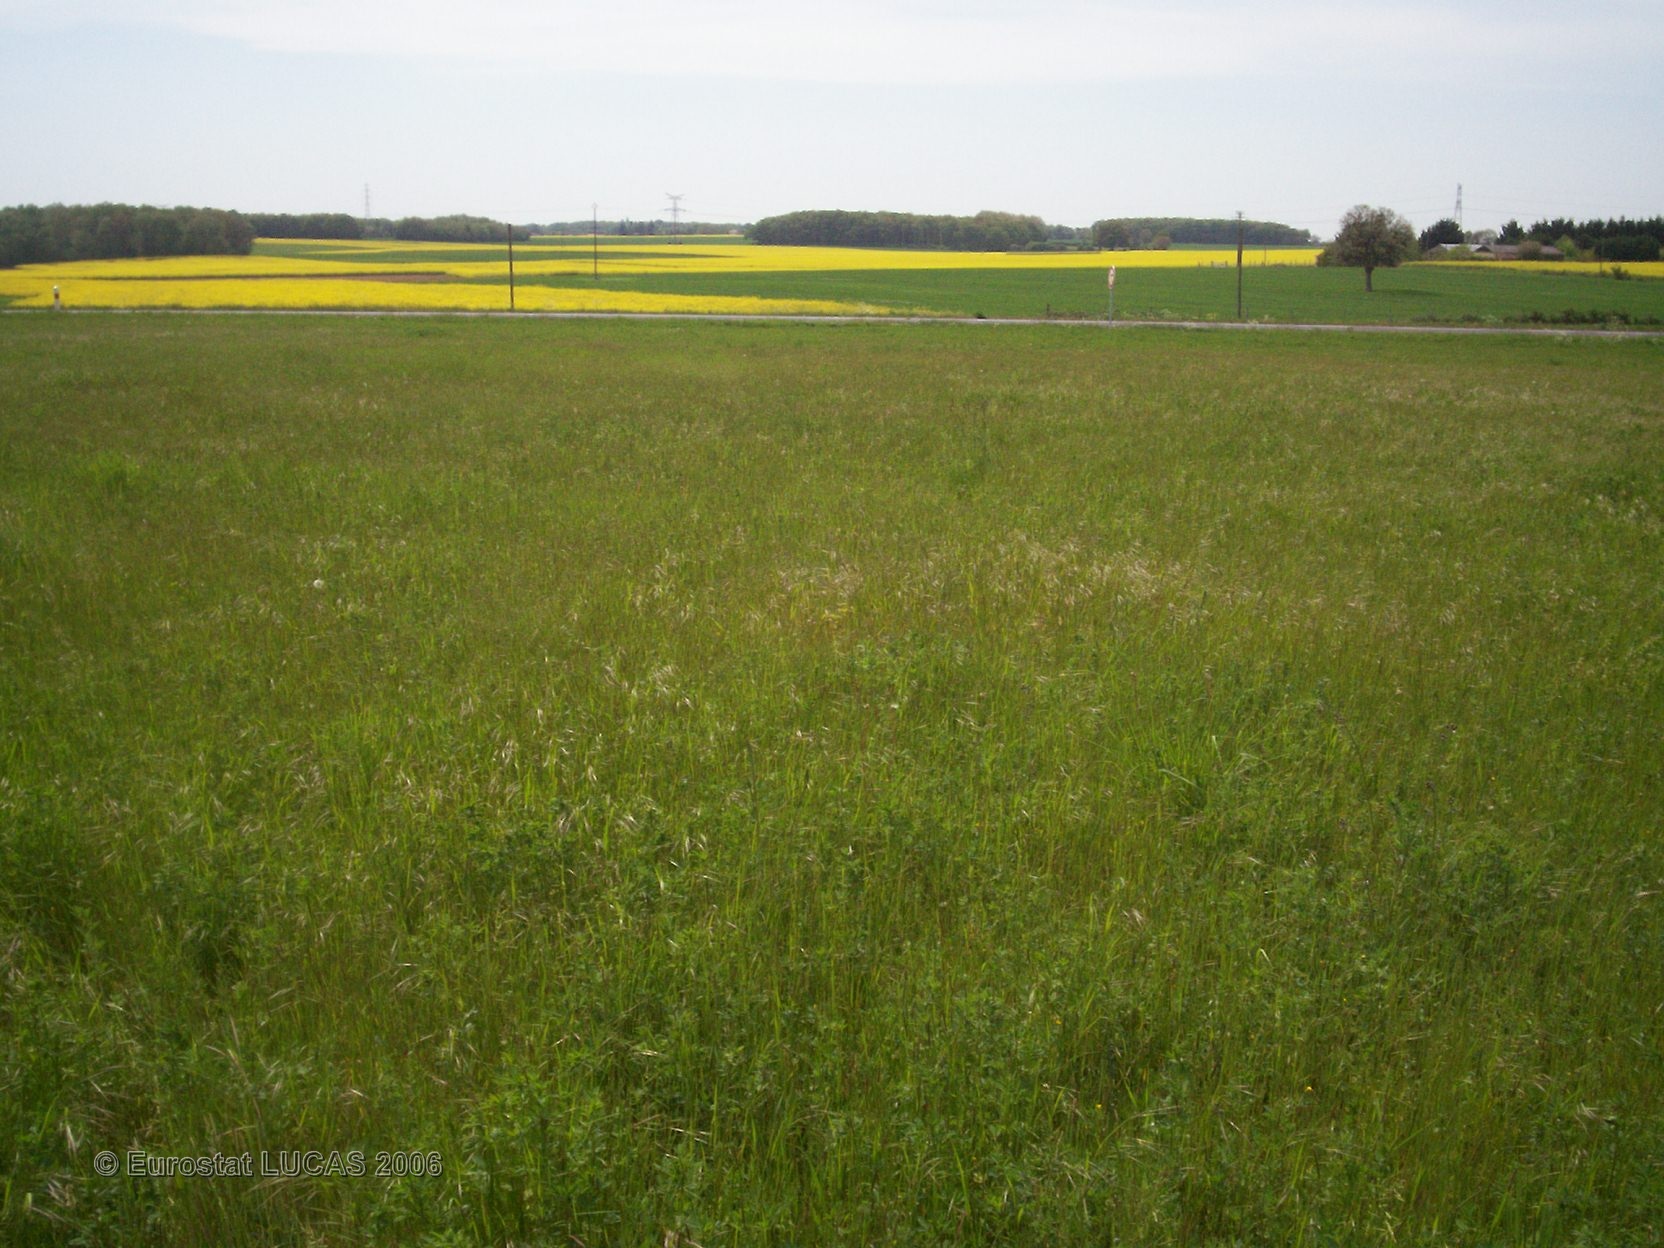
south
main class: Grassland
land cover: Grassland without tree/shrub cover
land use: Agriculture (excluding fallow land and kitchen gardens)
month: May
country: FR
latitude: 46.5596
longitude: 0.4727
